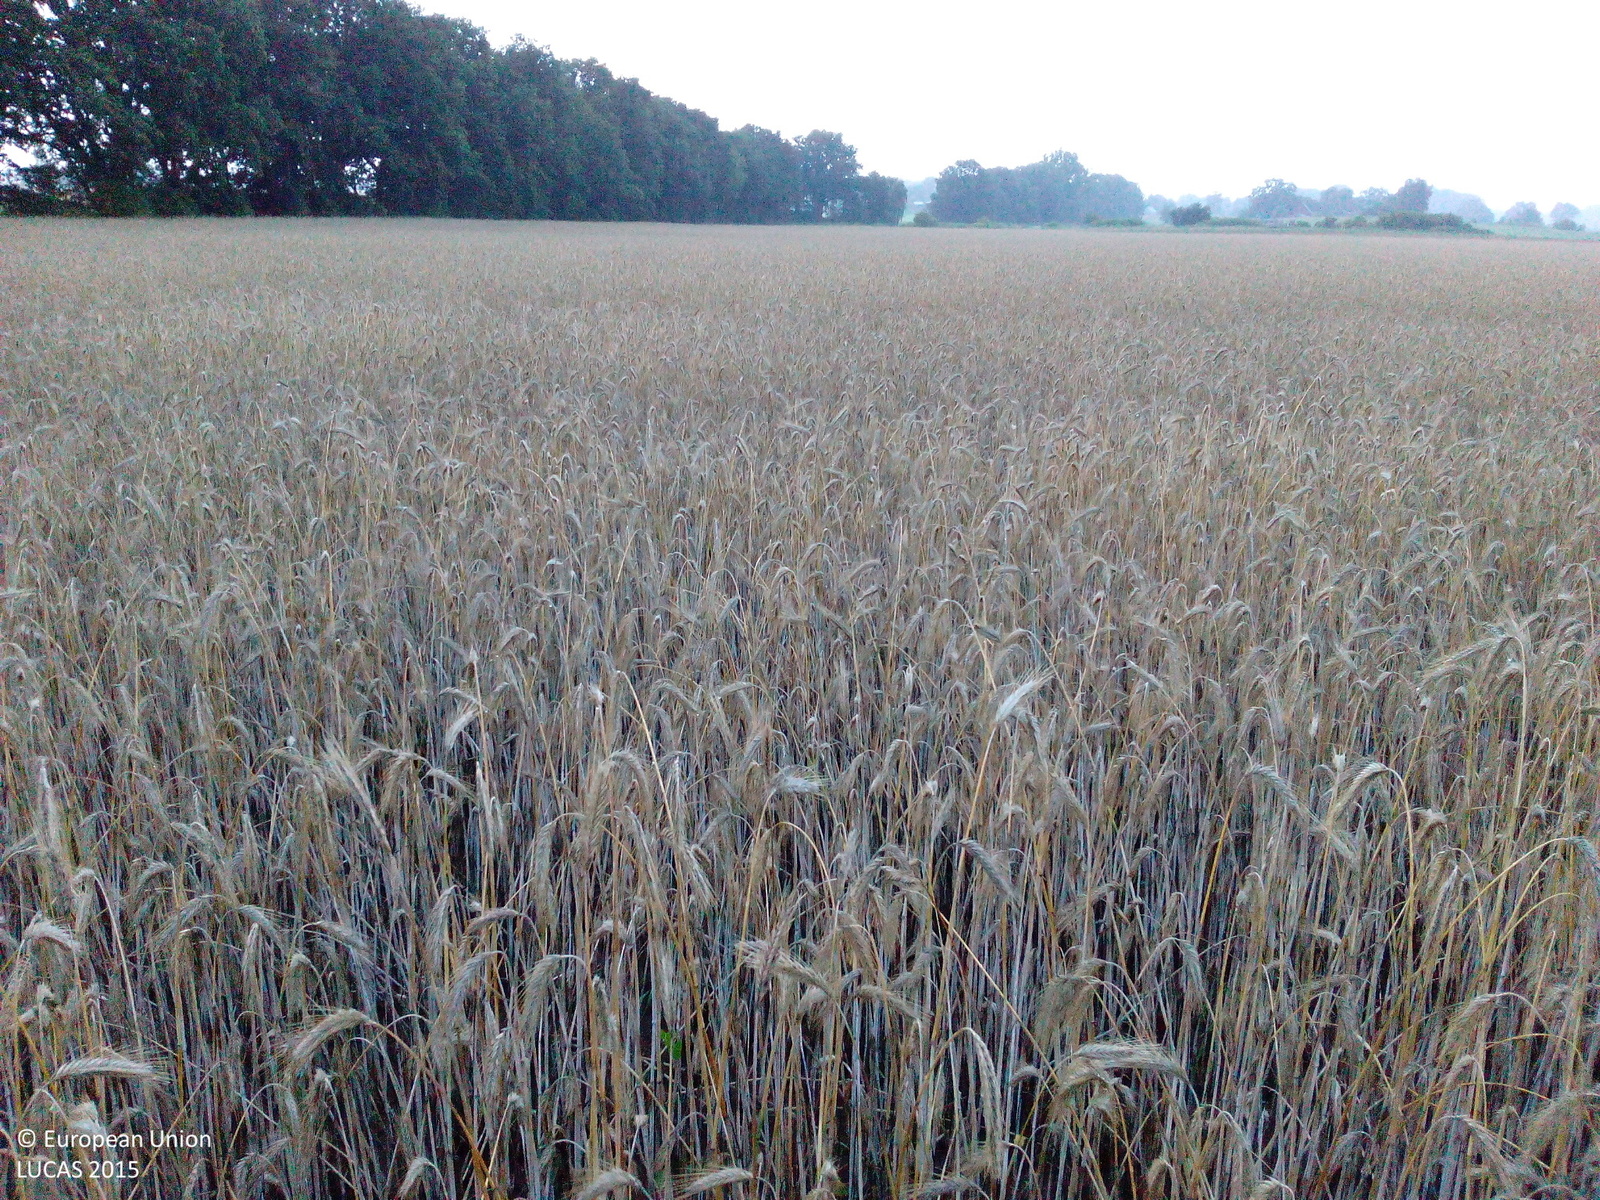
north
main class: Cropland
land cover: Rye
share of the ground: > 75 %
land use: Agriculture (excluding fallow land and kitchen gardens)
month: July
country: DE
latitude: 53.1617
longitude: 12.4373
